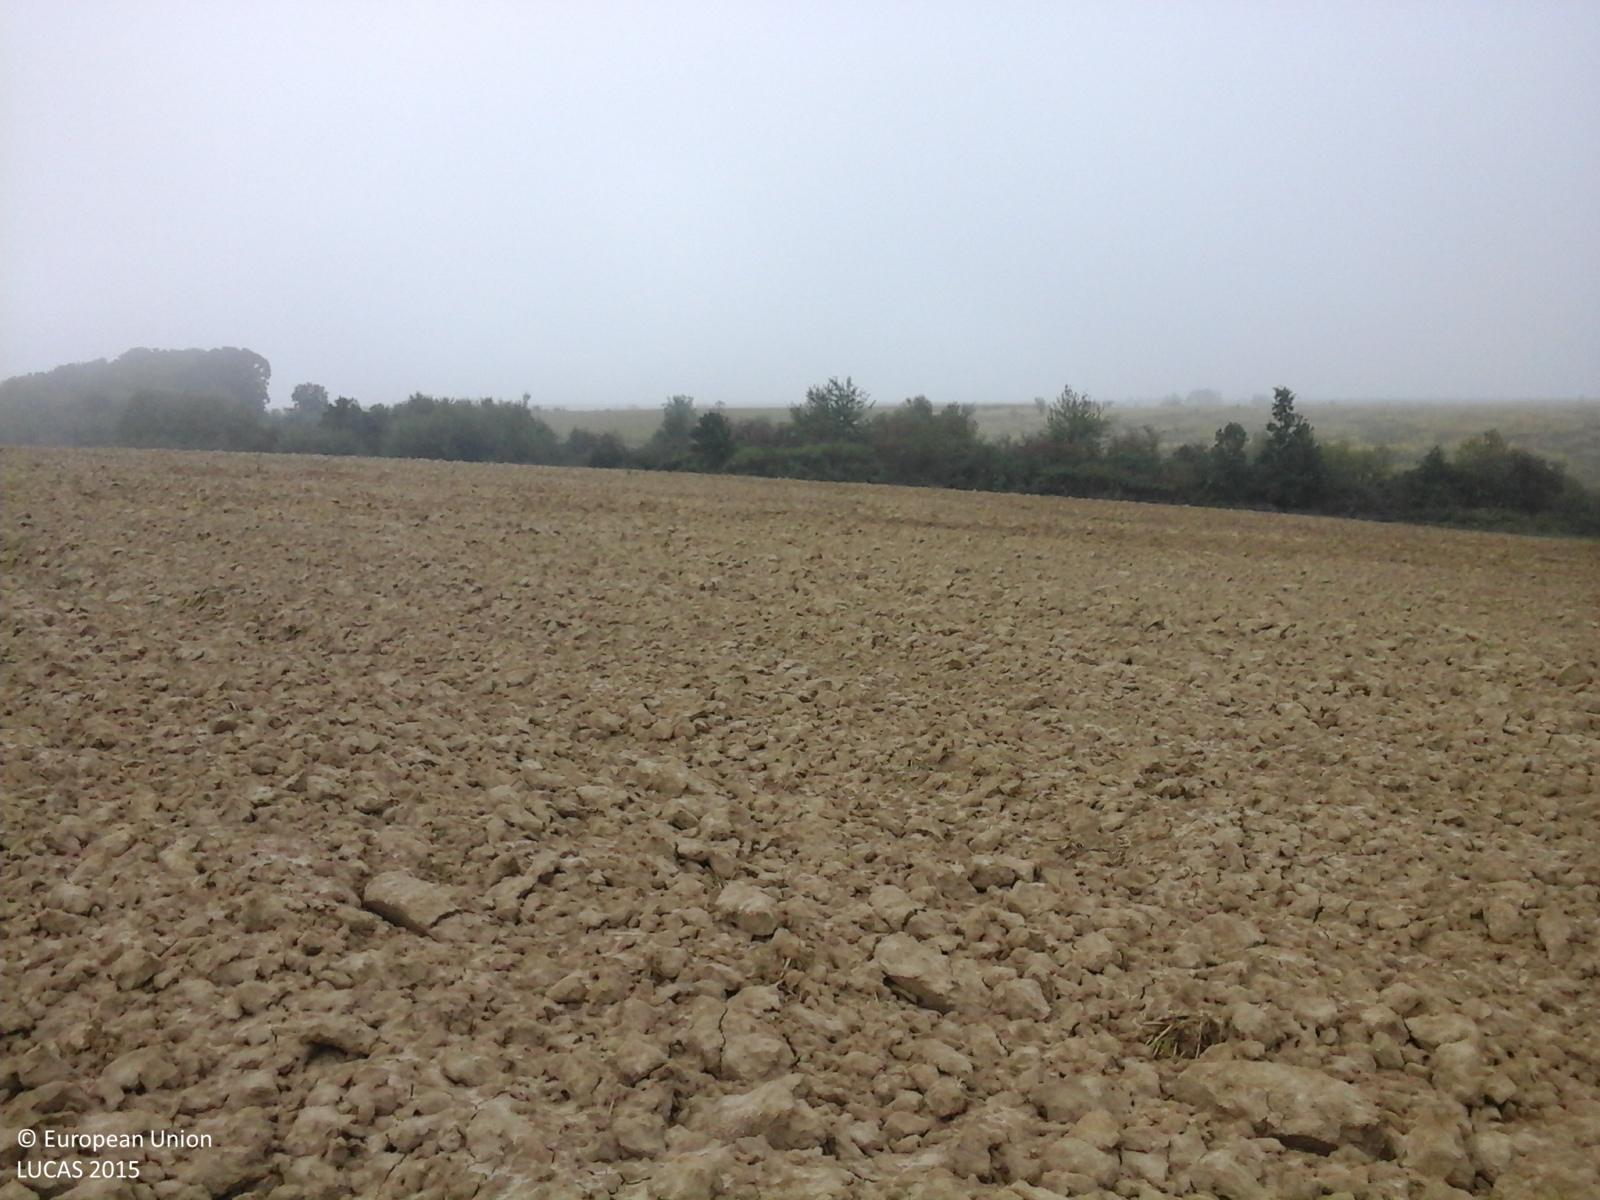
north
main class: Cropland
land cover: Common wheat
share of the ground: < 10 %
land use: Agriculture (excluding fallow land and kitchen gardens)
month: September
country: RO
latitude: 45.5616
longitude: 22.0180
